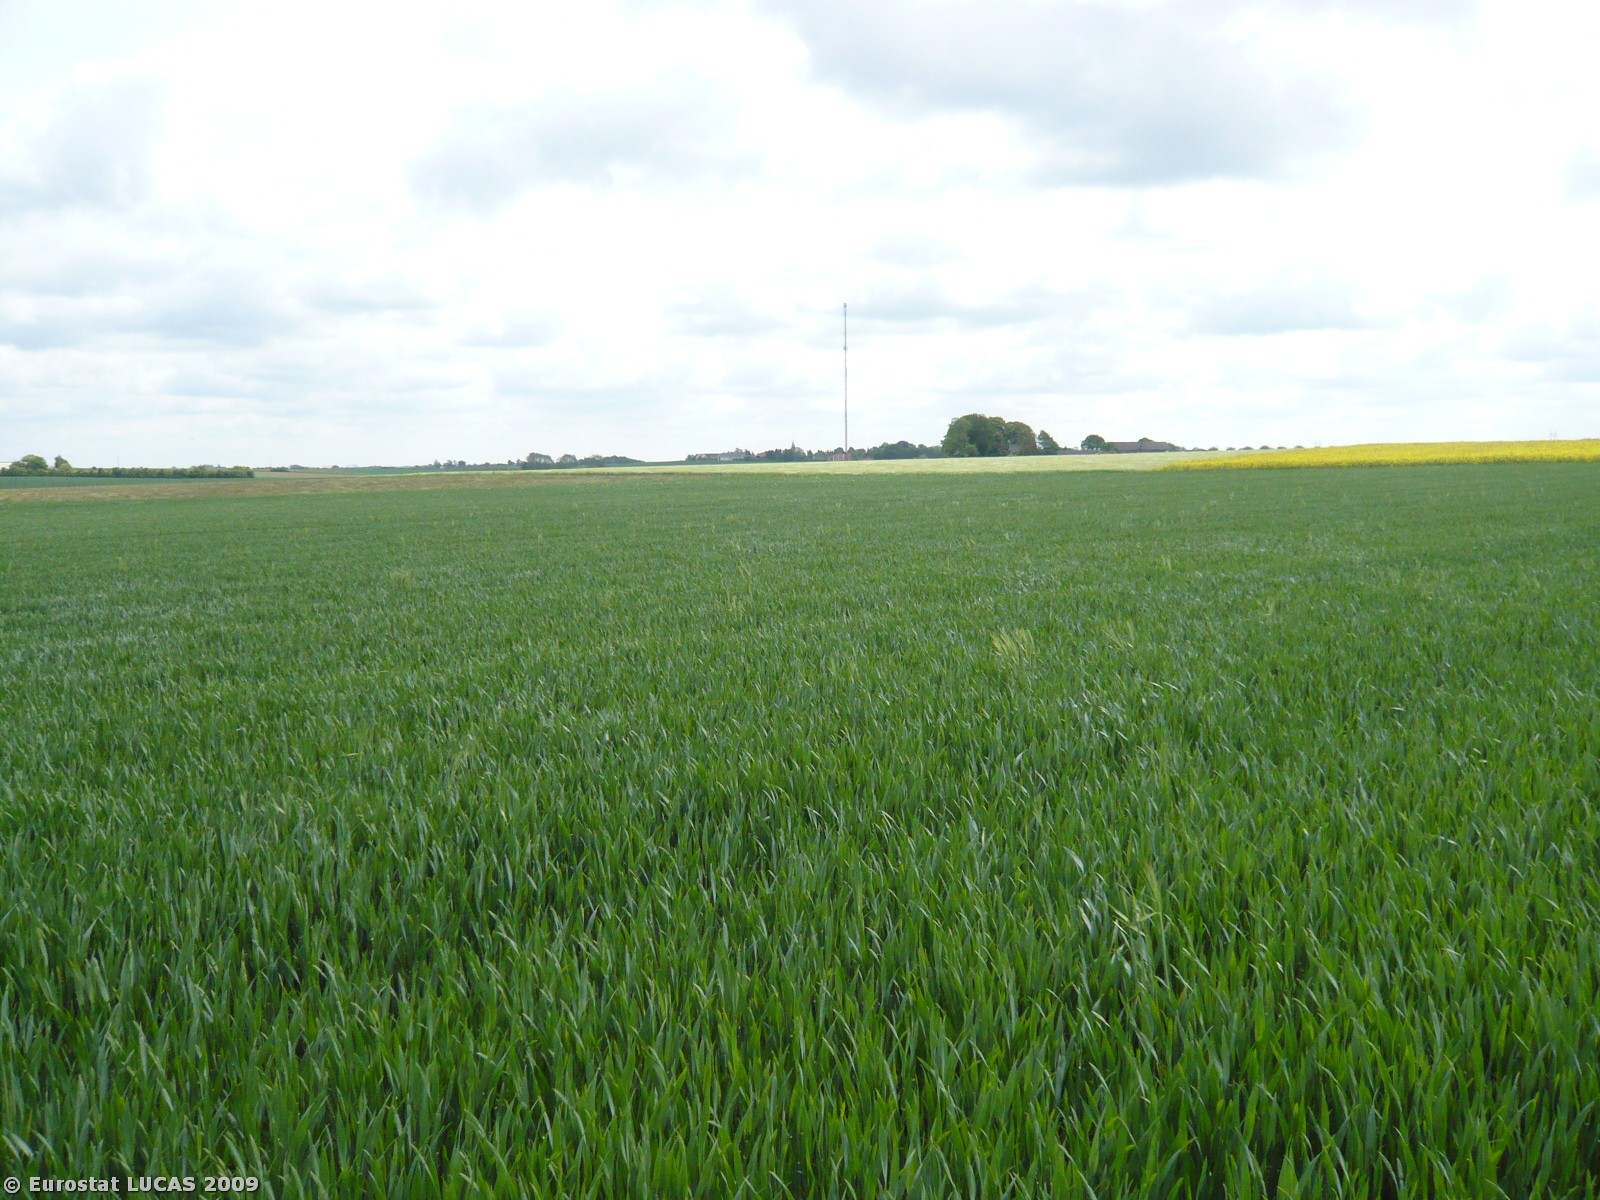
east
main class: Cropland
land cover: Common wheat
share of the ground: > 75 %
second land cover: Barley
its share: < 10 %
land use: Agriculture (excluding fallow land and kitchen gardens)
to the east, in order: Common wheat; Grassland without tree/shrub cover; Barley; Common wheat
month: May
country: DK
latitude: 55.4741
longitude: 11.7862
